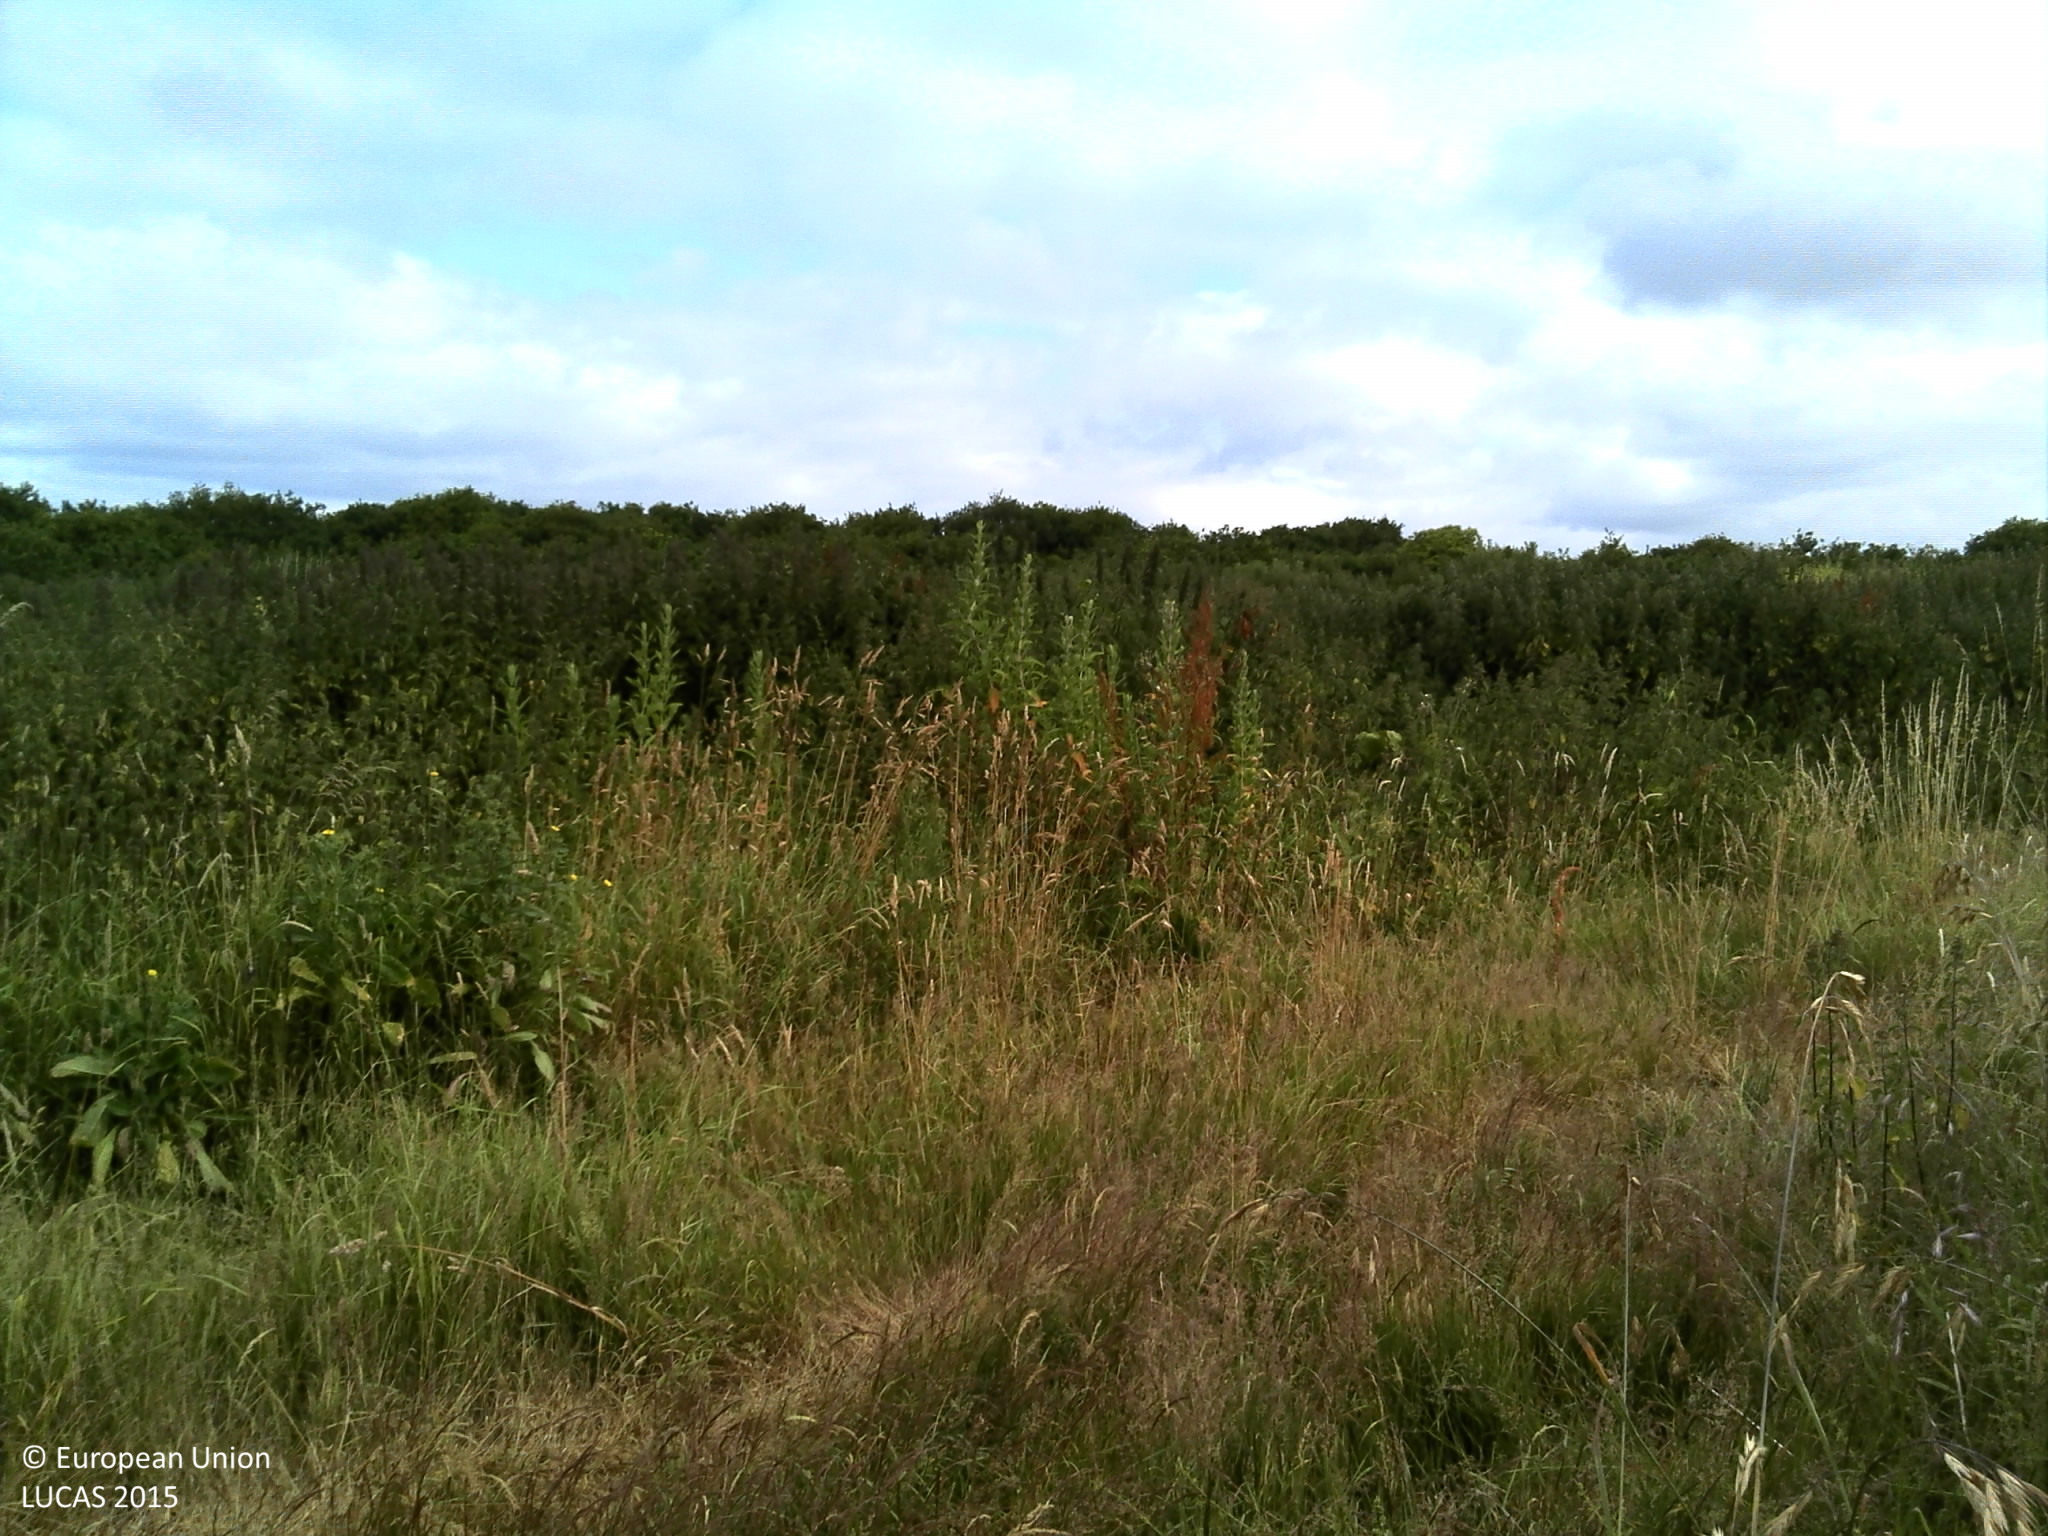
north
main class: Woodland
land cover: Pine dominated mixed woodland
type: hemiboreal forest and nemoral coniferous forest and mixed broadleaved-coniferous forest
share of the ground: > 75 %
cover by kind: coniferous forest trees 50 %, broadleaved forest trees 25 %, shrubs 10 %, herbaceous plants 5 %, lichens and mosses 5 %, consolidated bare surface 5 %
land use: Forestry
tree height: > 5 m
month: June
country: FR
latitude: 48.2533
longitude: -4.4406
